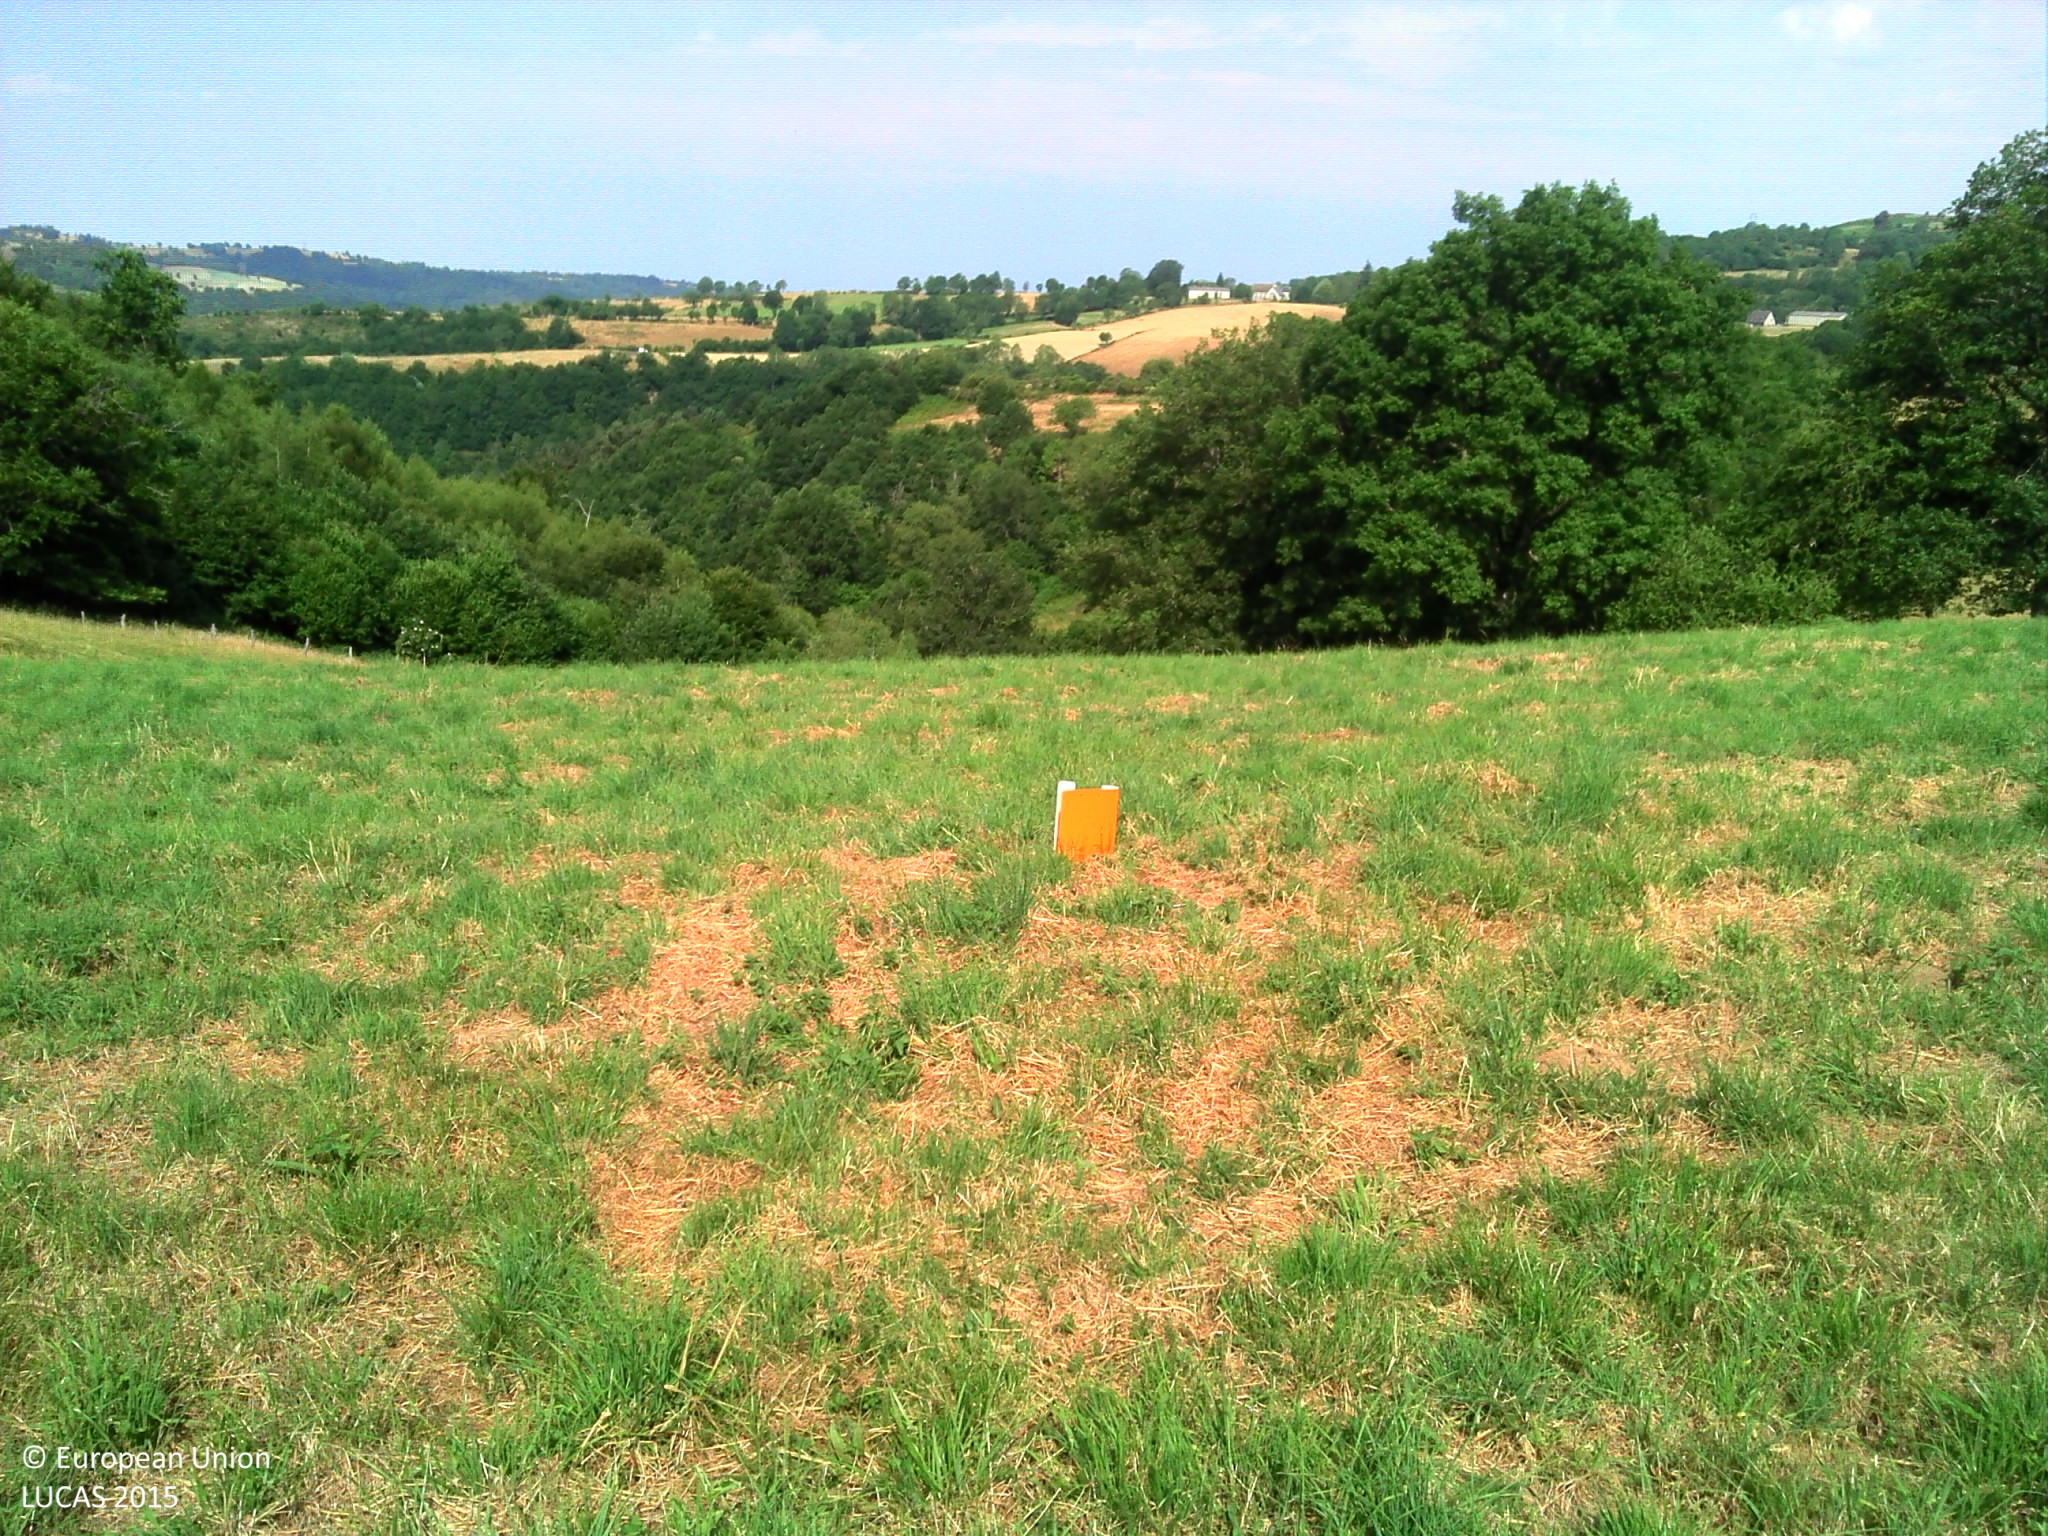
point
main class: Grassland
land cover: Grassland without tree/shrub cover
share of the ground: > 75 %
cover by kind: herbaceous plants 100 %
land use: Agriculture (excluding fallow land and kitchen gardens)
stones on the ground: < 10 %
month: July
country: FR
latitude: 44.8528
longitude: 2.9545
